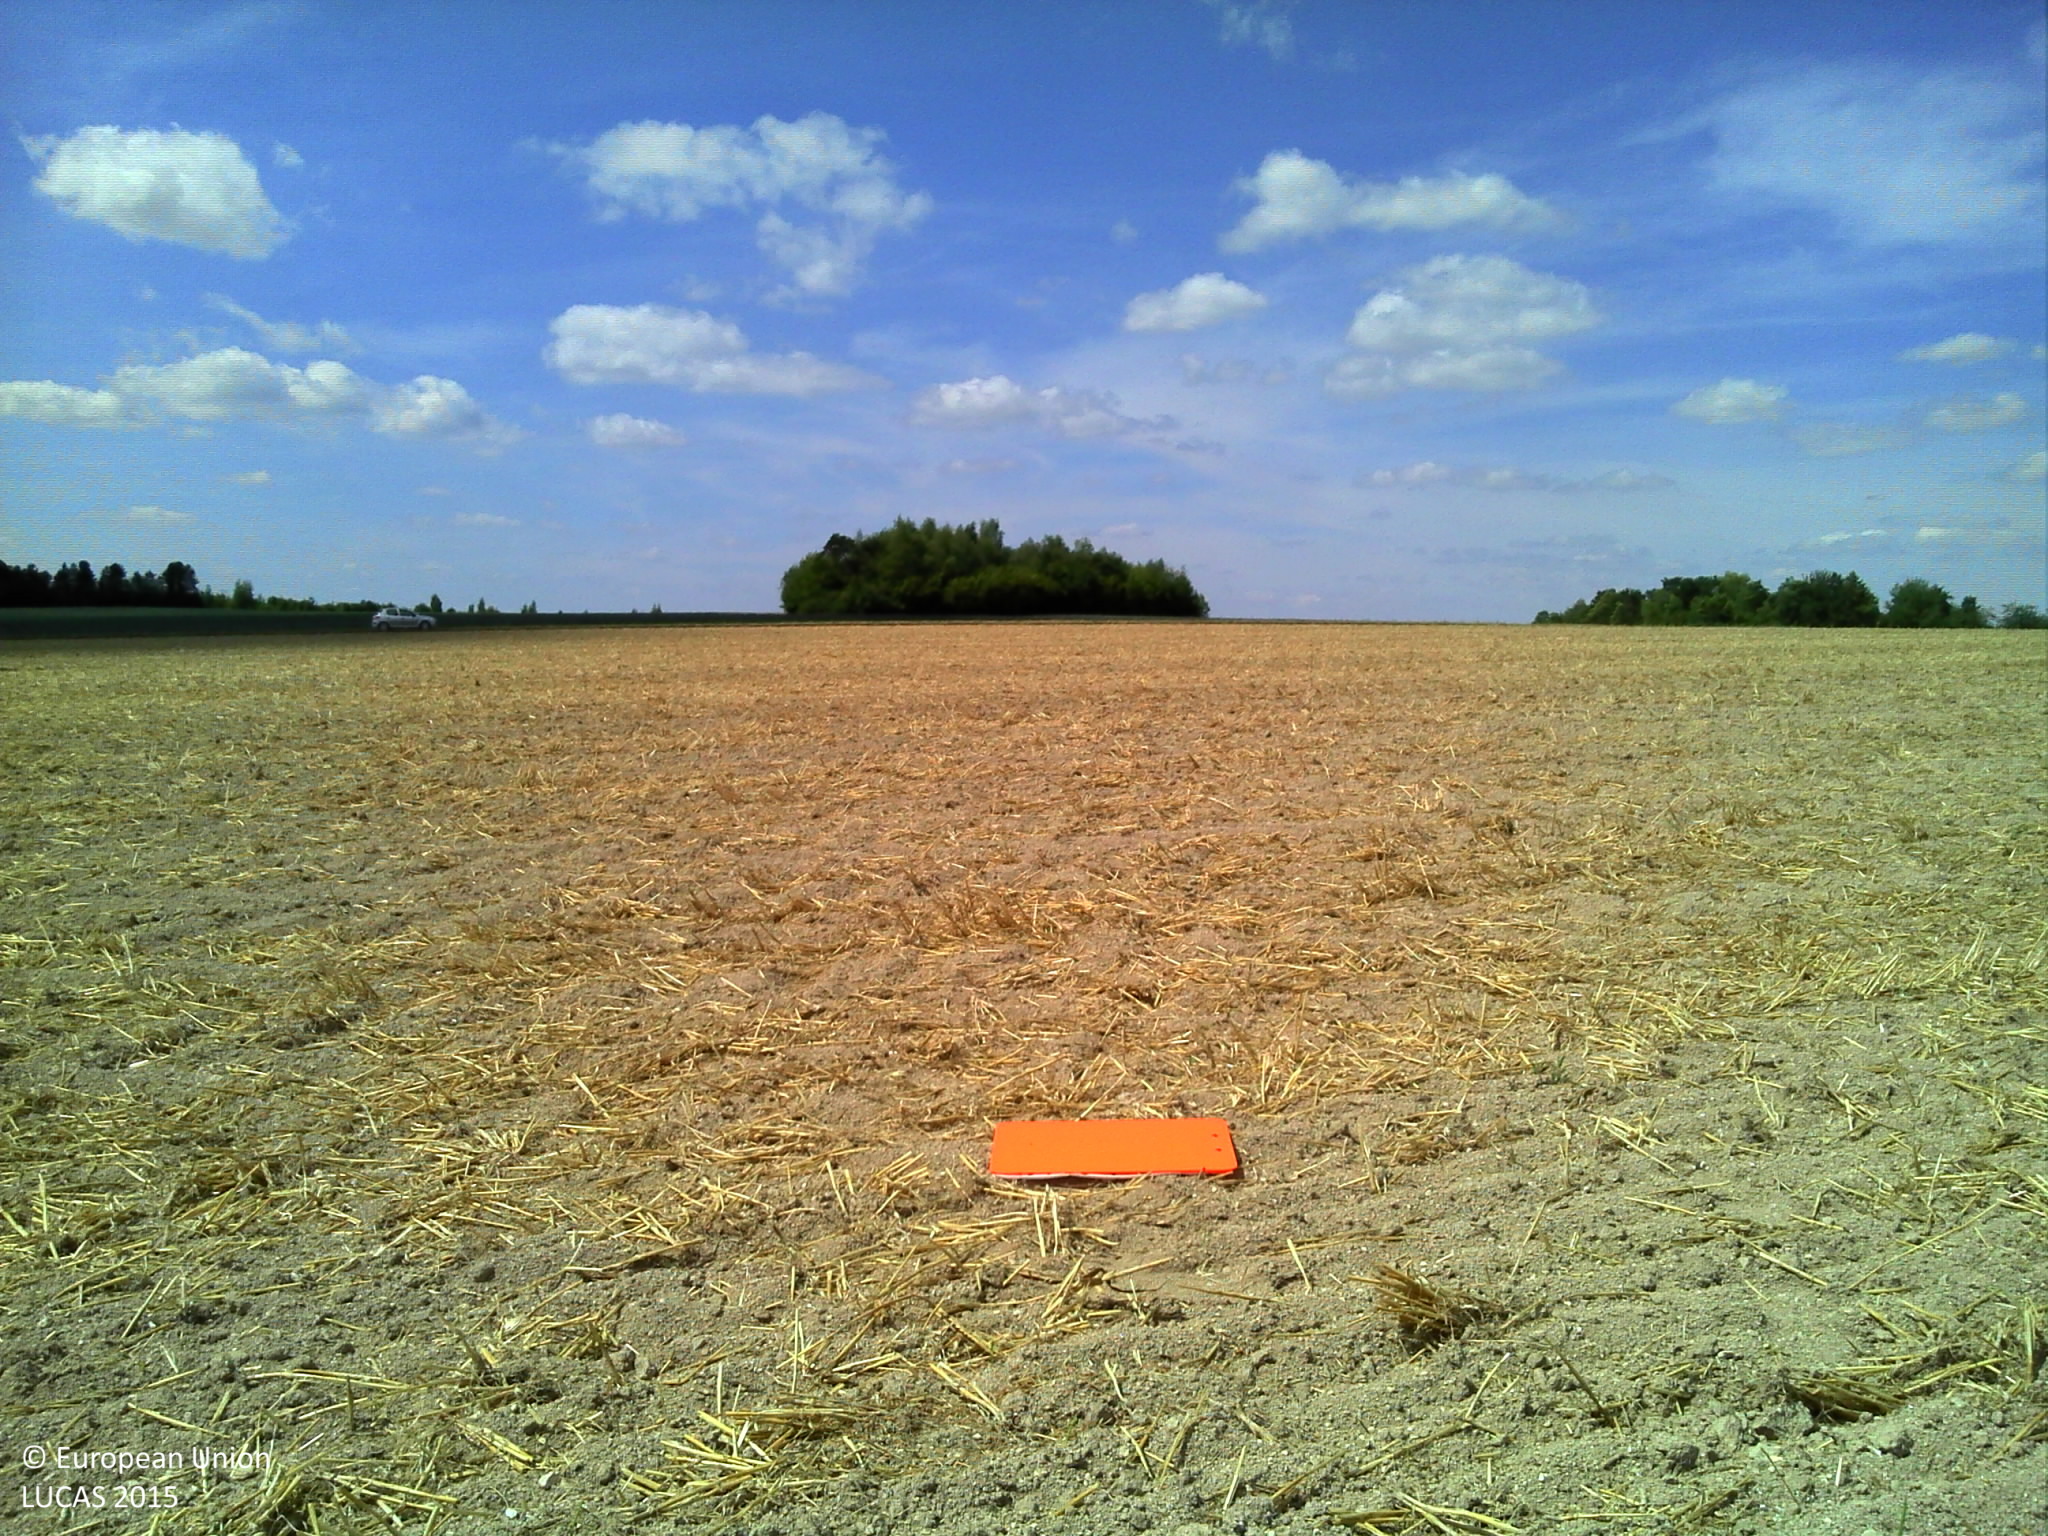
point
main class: Cropland
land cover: Barley
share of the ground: > 75 %
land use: Agriculture (excluding fallow land and kitchen gardens)
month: August
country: FR
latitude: 49.1764
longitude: 4.3032
